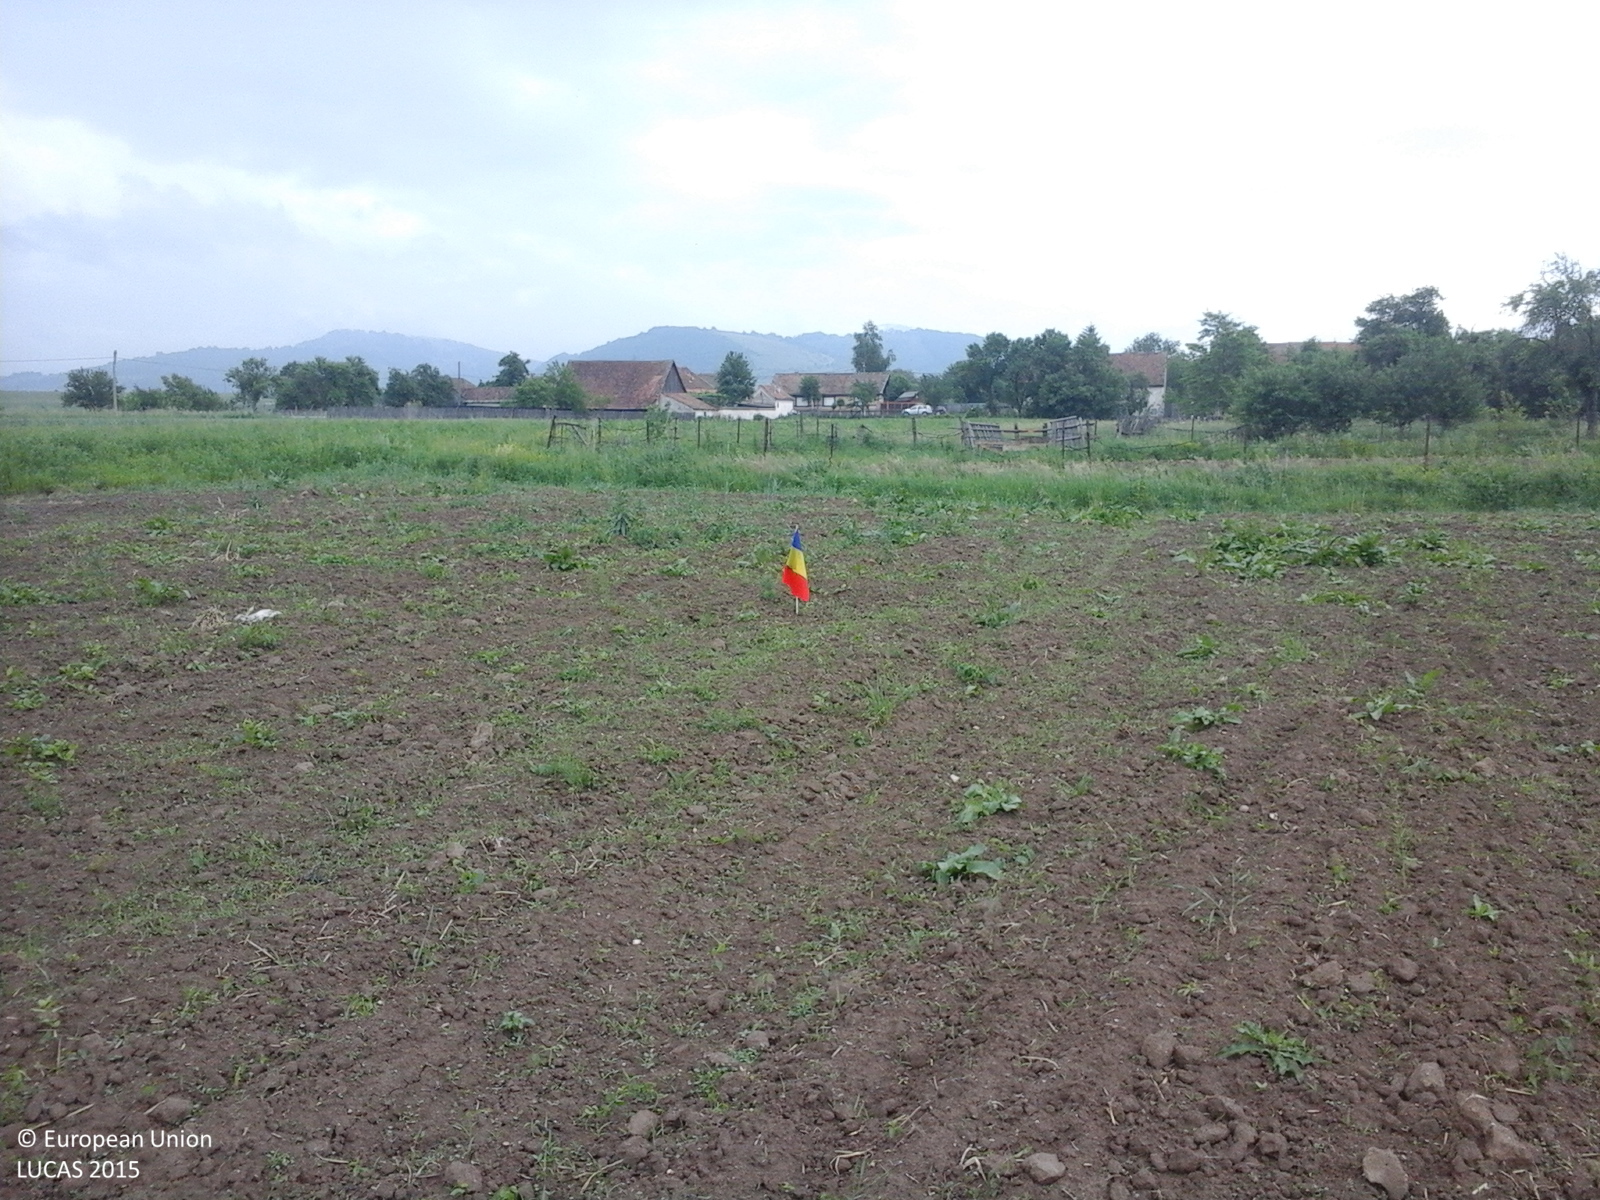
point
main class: Cropland
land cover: Lucerne
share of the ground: 10 - 25 %
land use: Agriculture (excluding fallow land and kitchen gardens)
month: May
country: RO
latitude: 45.8782
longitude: 25.2106
